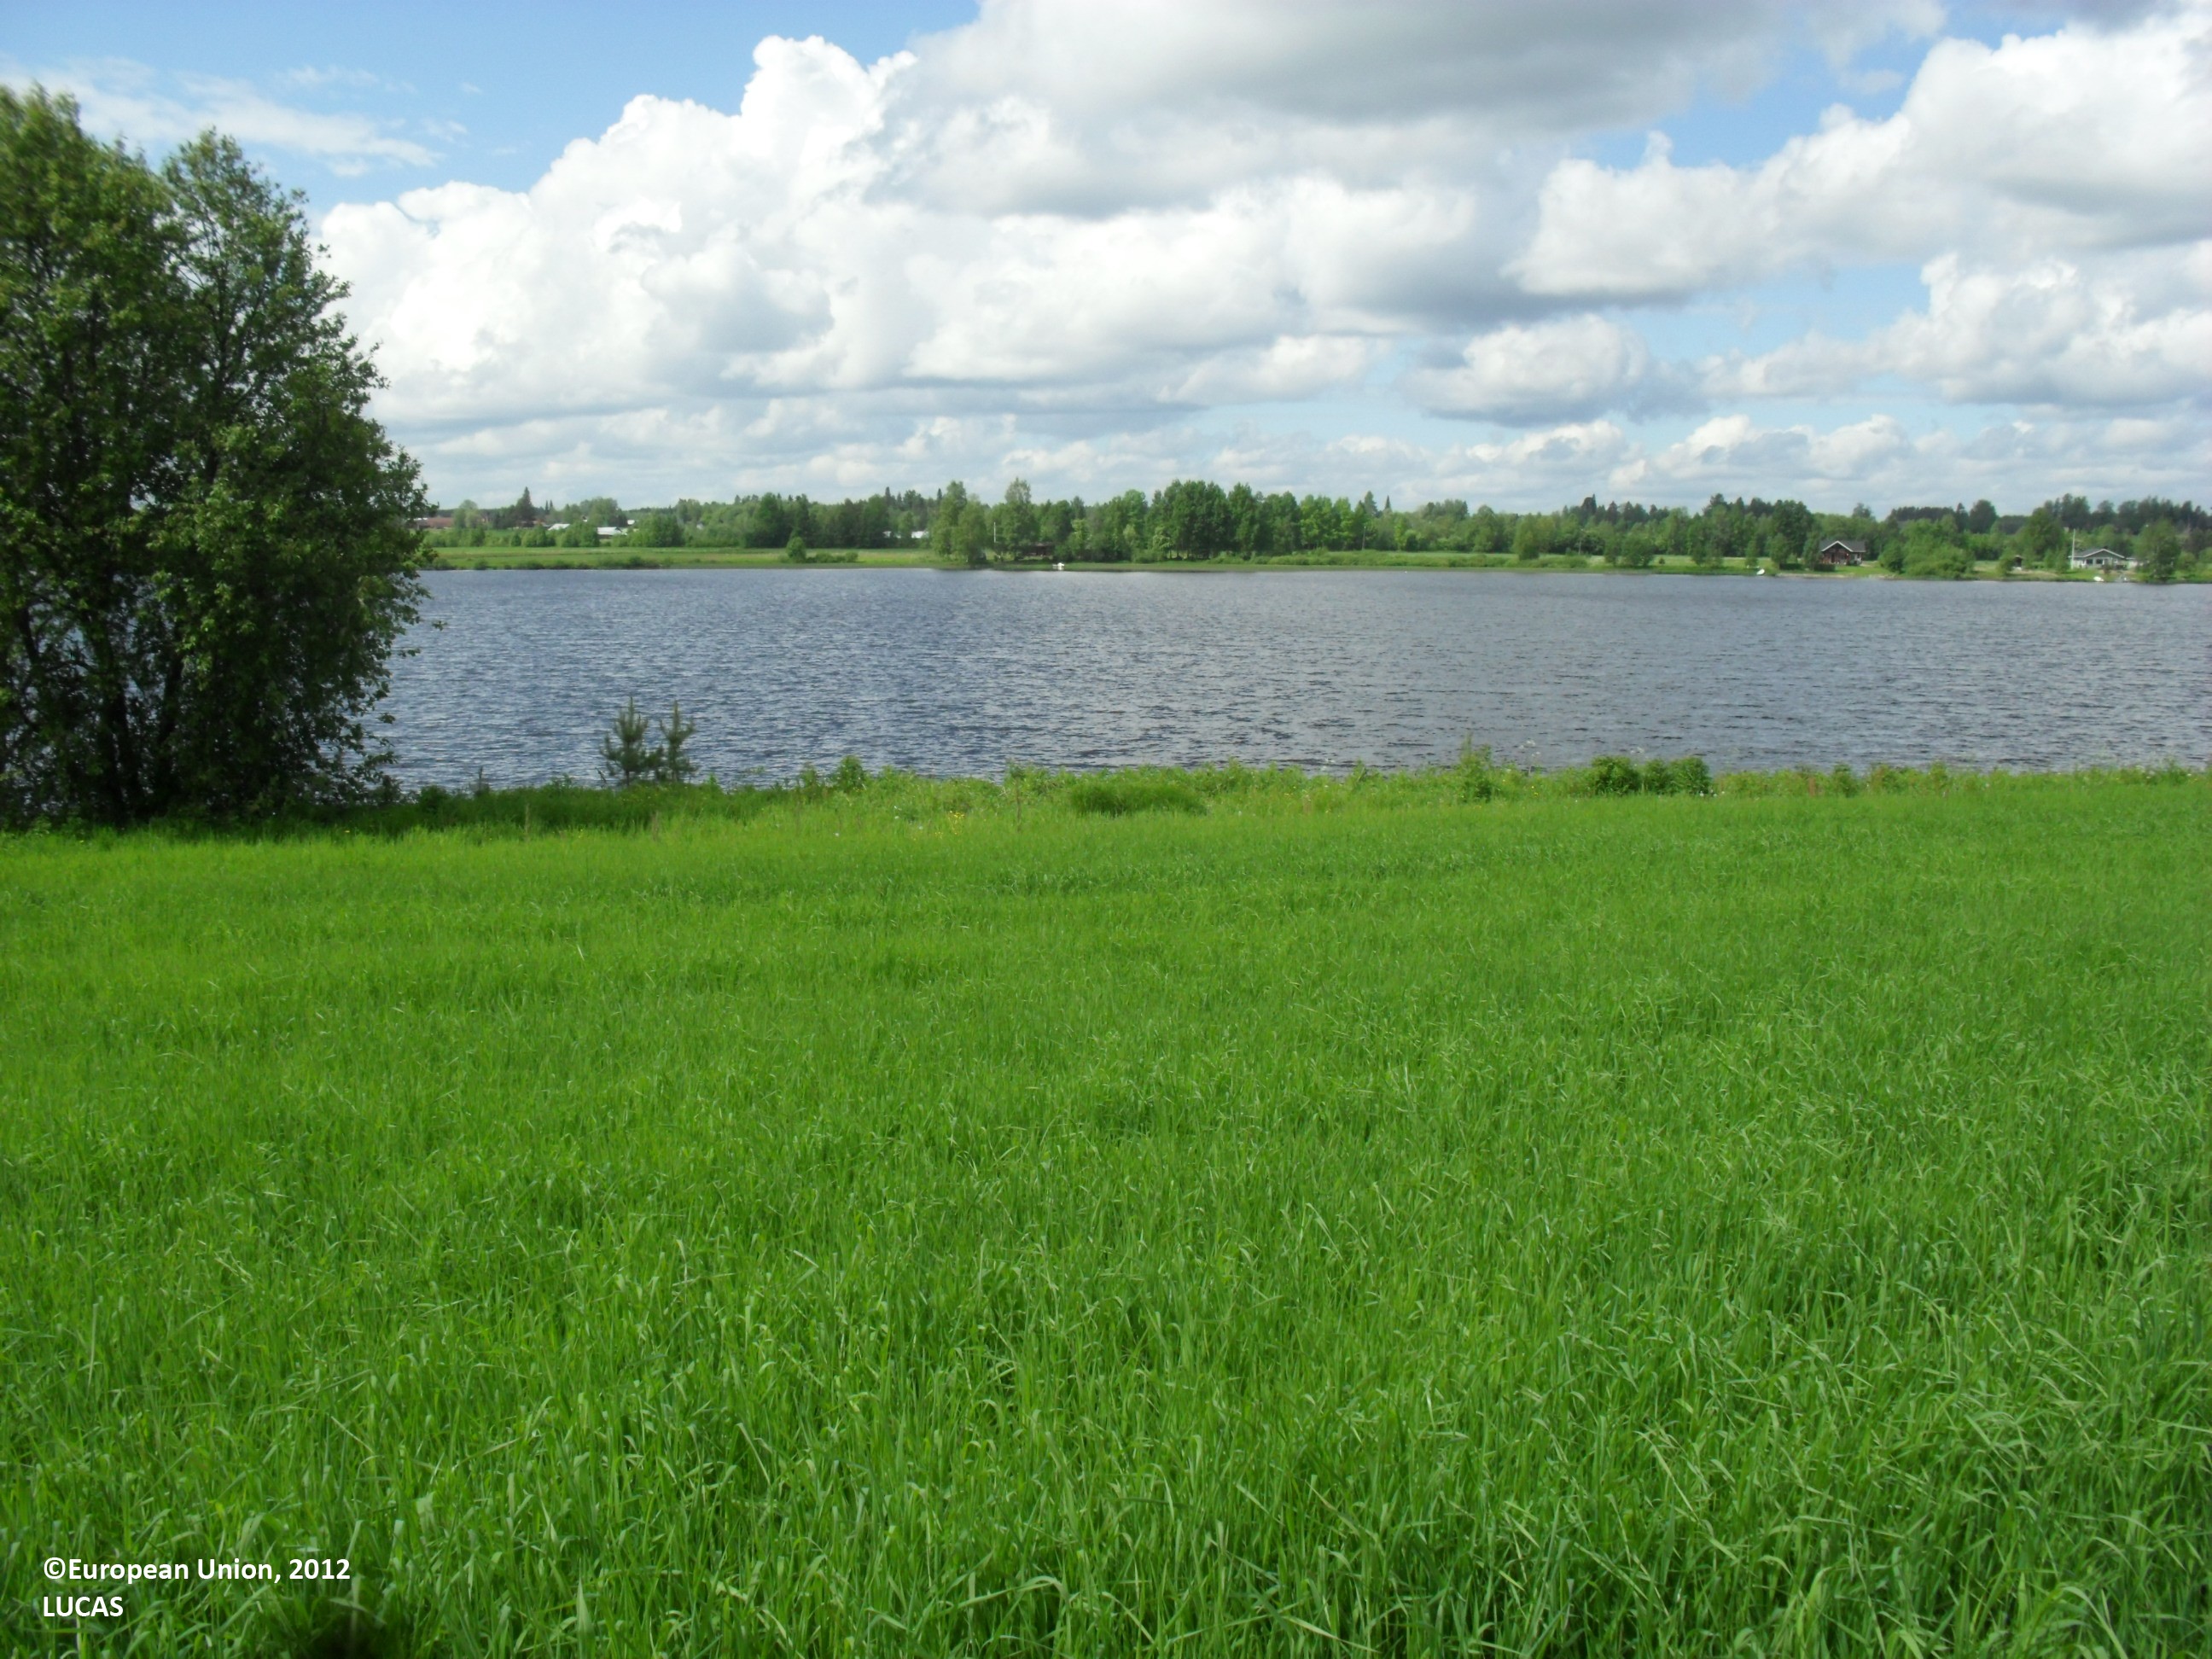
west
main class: Cropland
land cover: Temporary grasslands
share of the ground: > 75 %
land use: Agriculture (excluding fallow land and kitchen gardens)
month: June
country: FI
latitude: 62.7512
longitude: 23.5188
